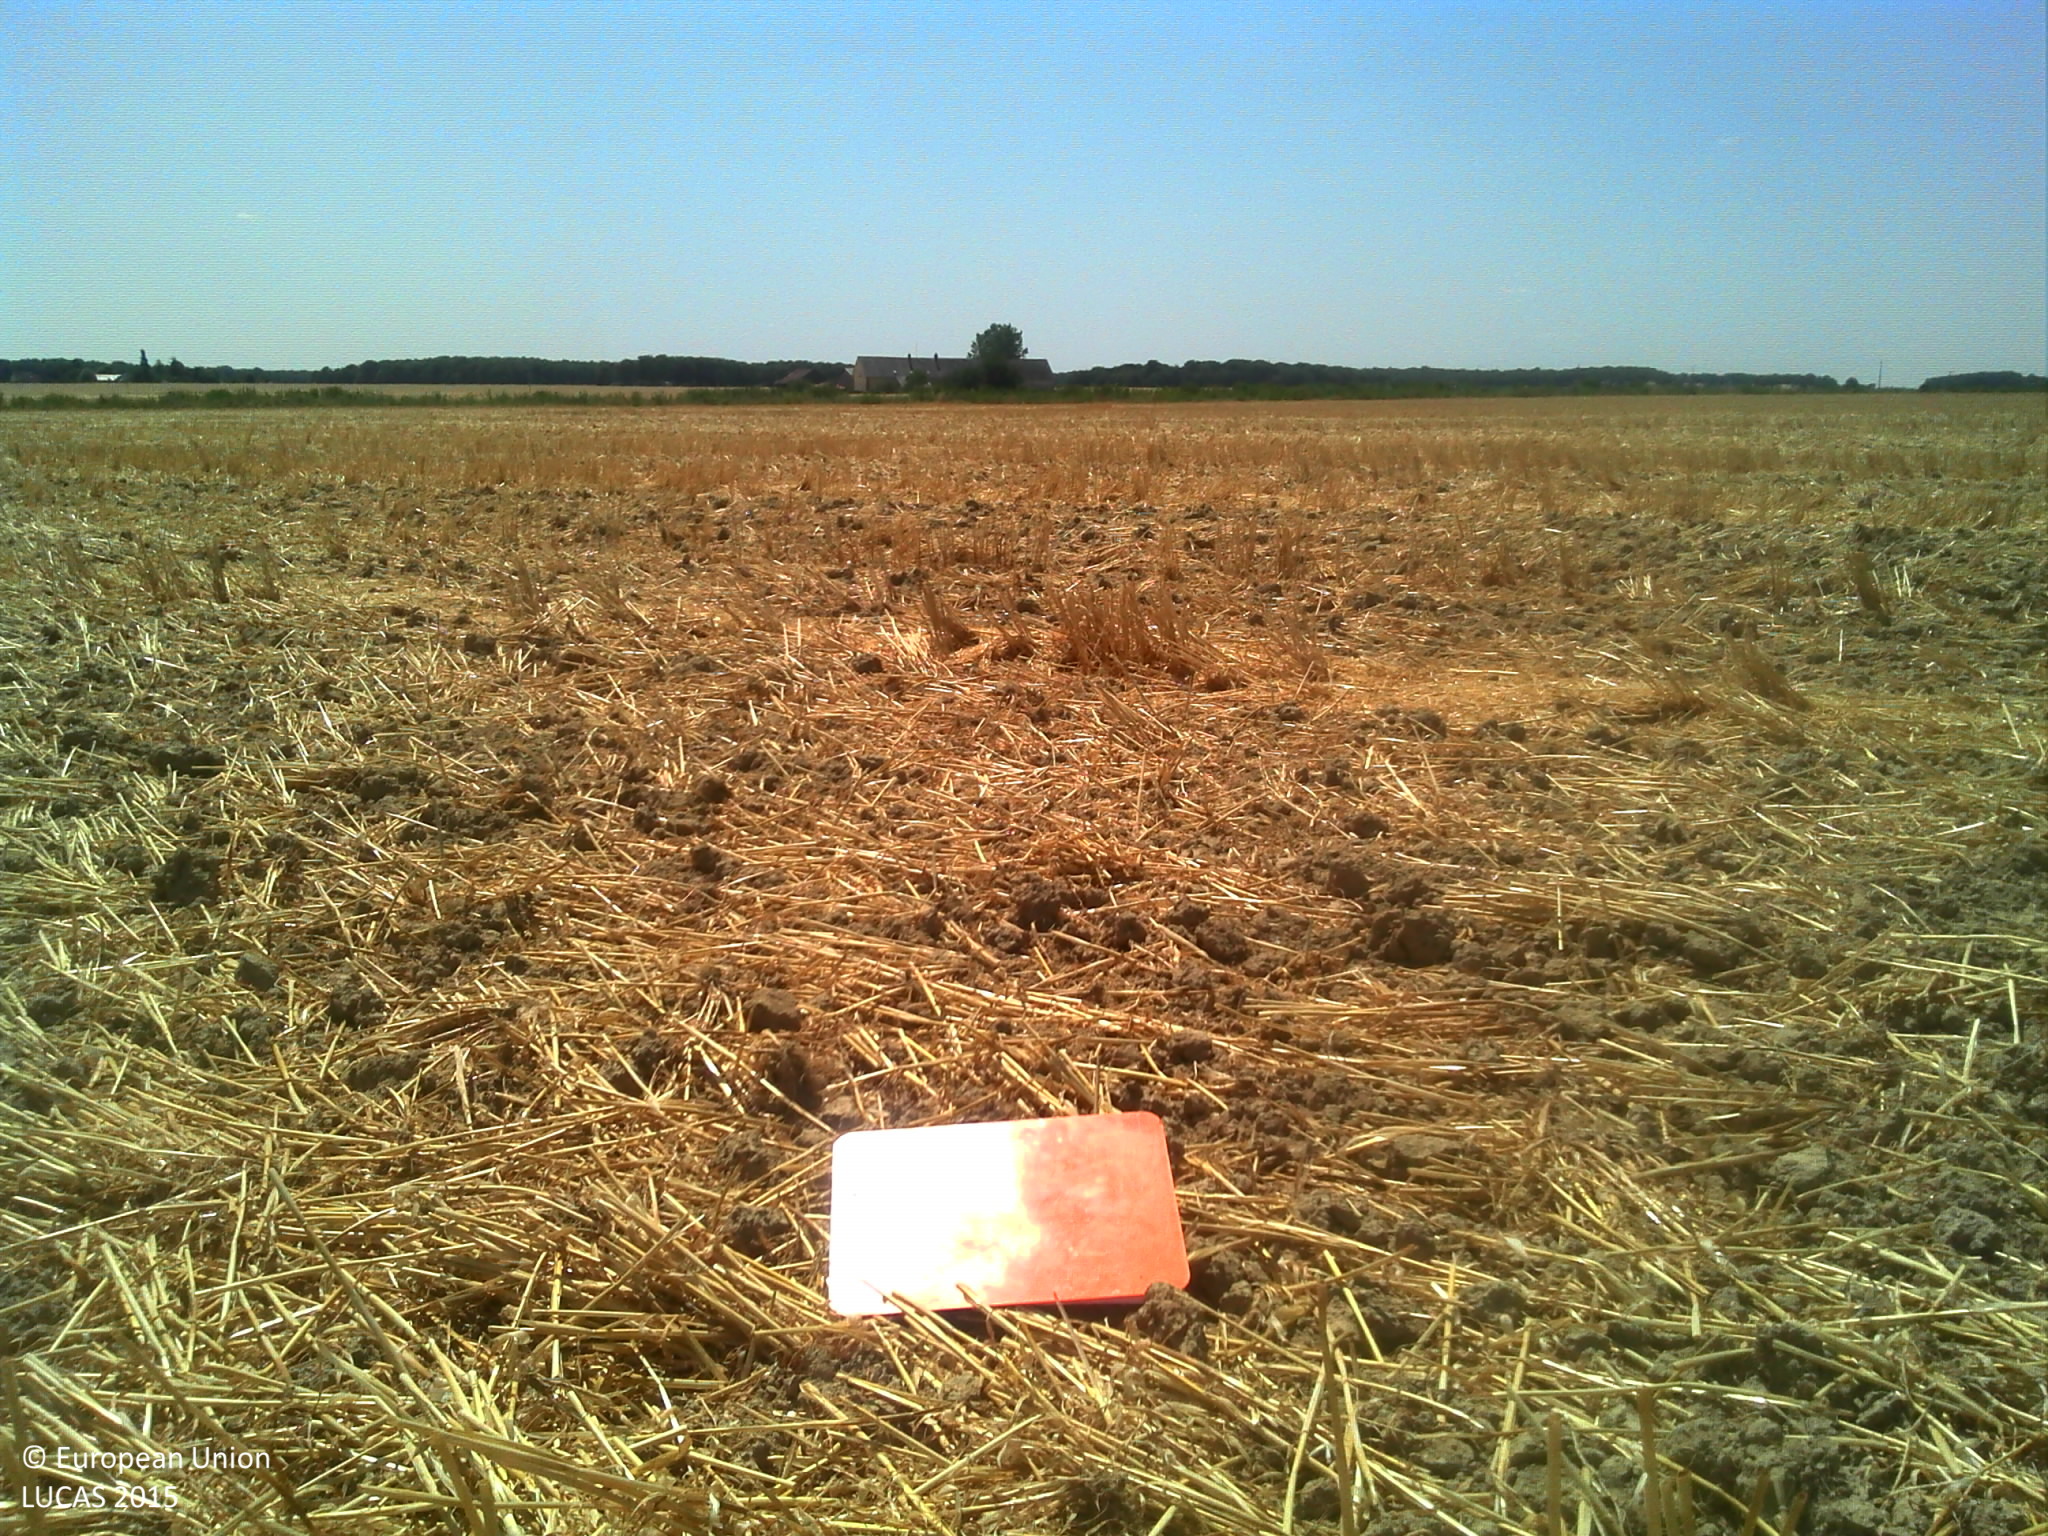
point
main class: Cropland
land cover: Barley
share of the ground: > 75 %
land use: Agriculture (excluding fallow land and kitchen gardens)
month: July
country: FR
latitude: 48.1694
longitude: 1.3096
